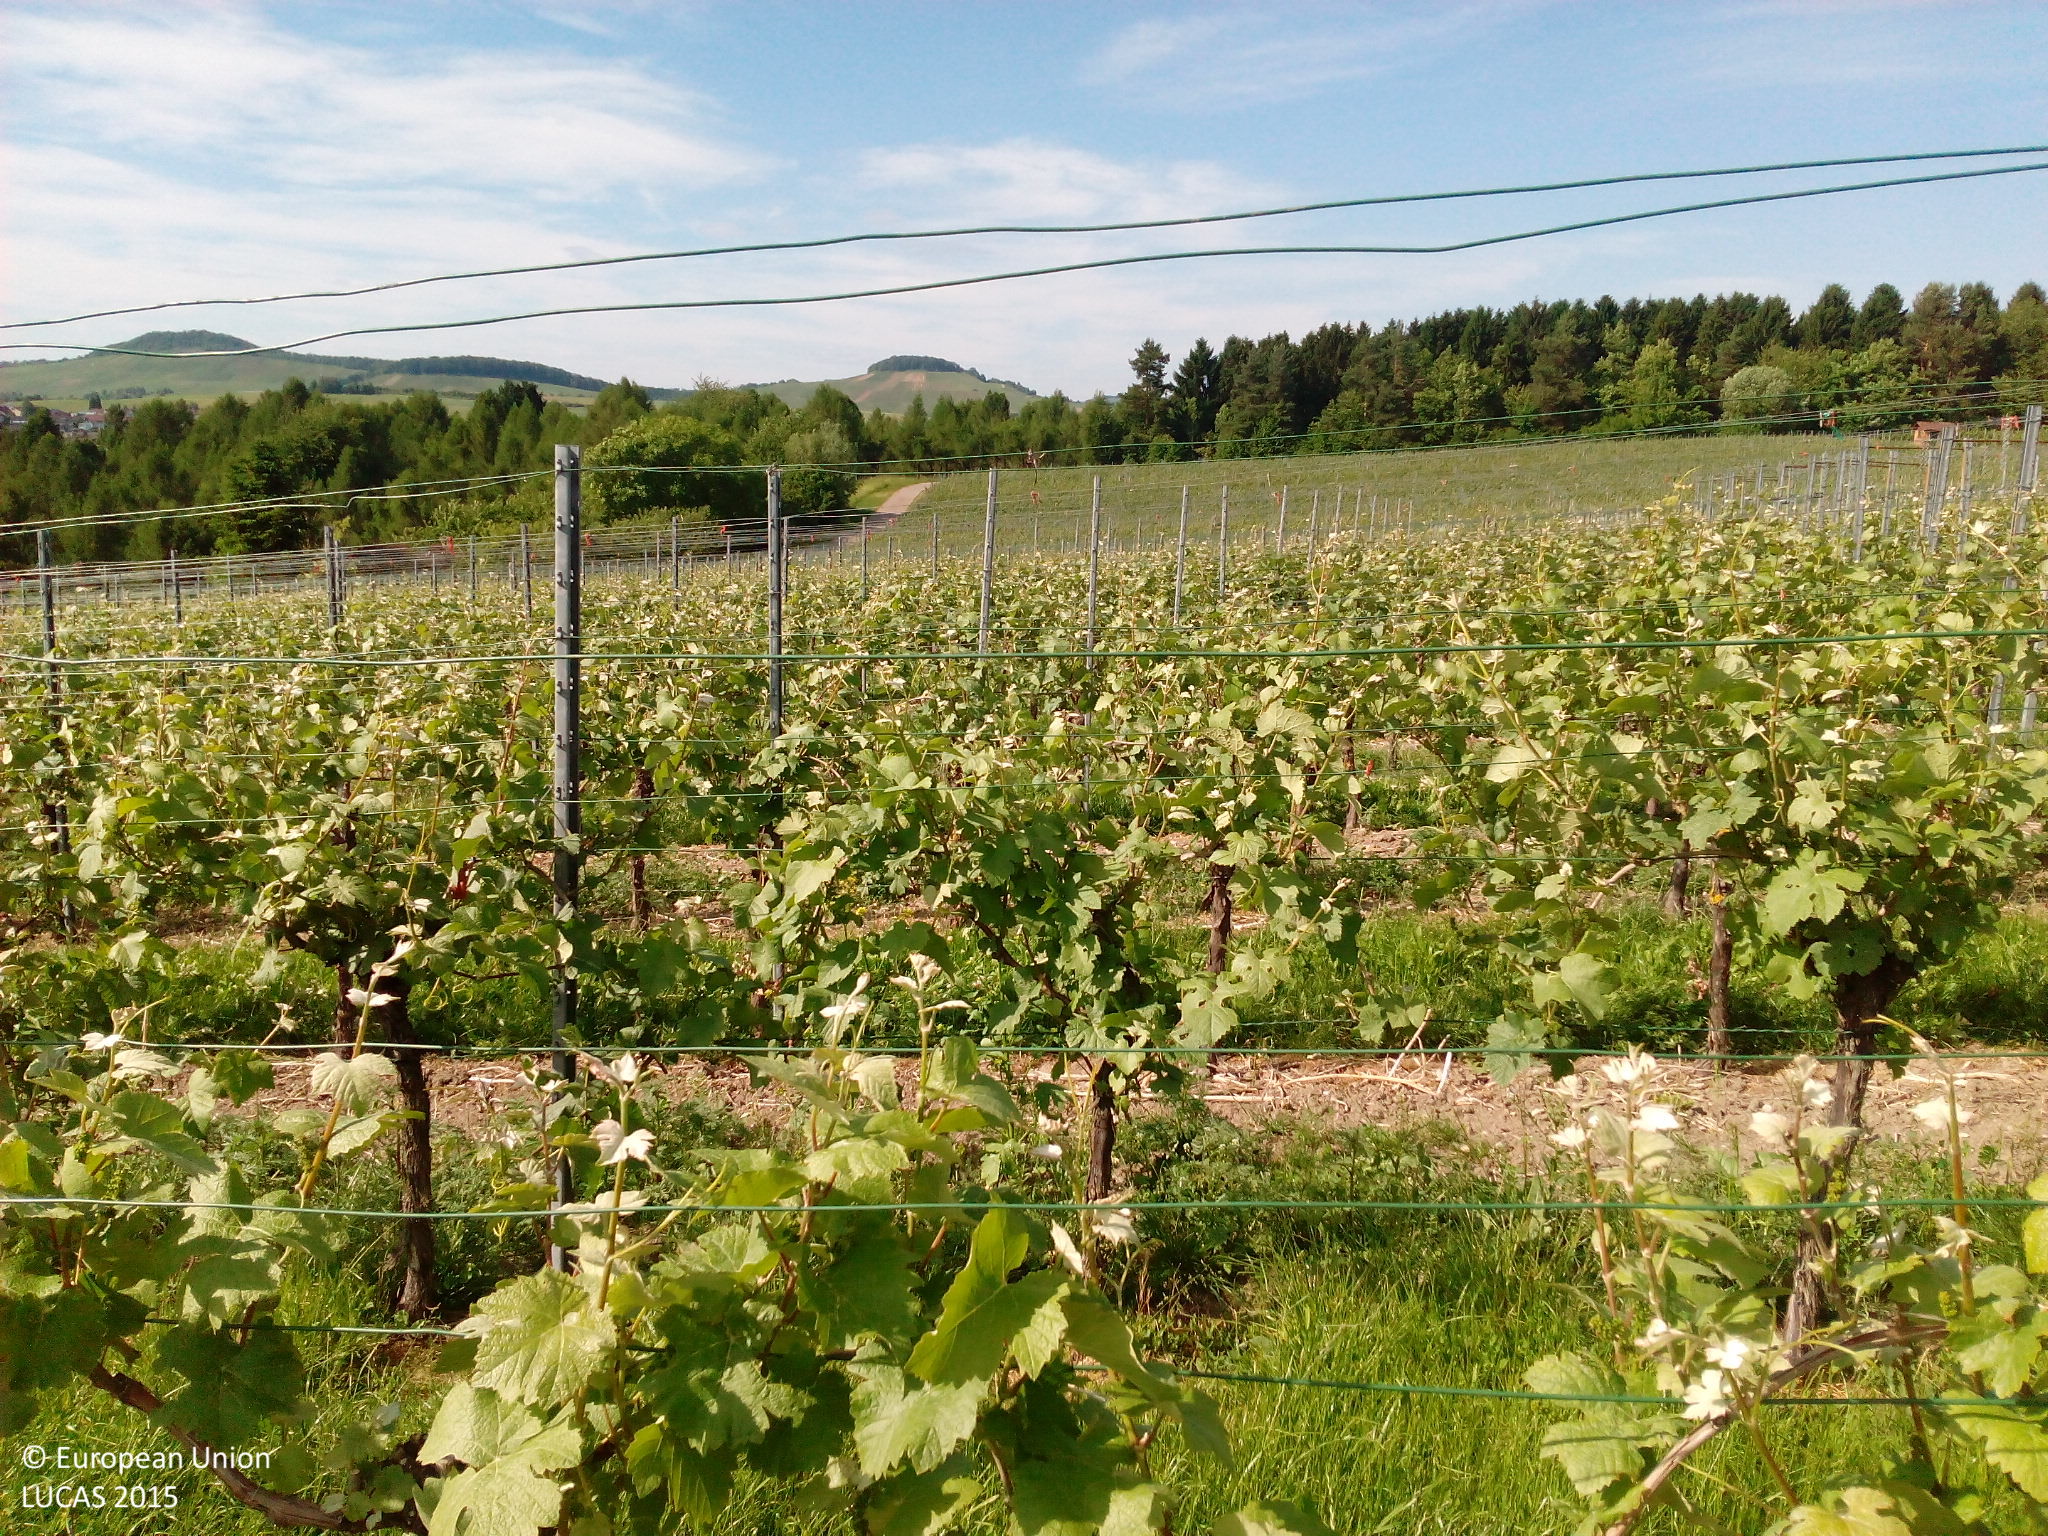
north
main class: Cropland
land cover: Vineyards
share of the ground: 25 - 50 %
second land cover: Grassland without tree/shrub cover
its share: > 75 %
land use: Agriculture (excluding fallow land and kitchen gardens)
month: June
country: DE
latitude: 48.9950
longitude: 9.3033
